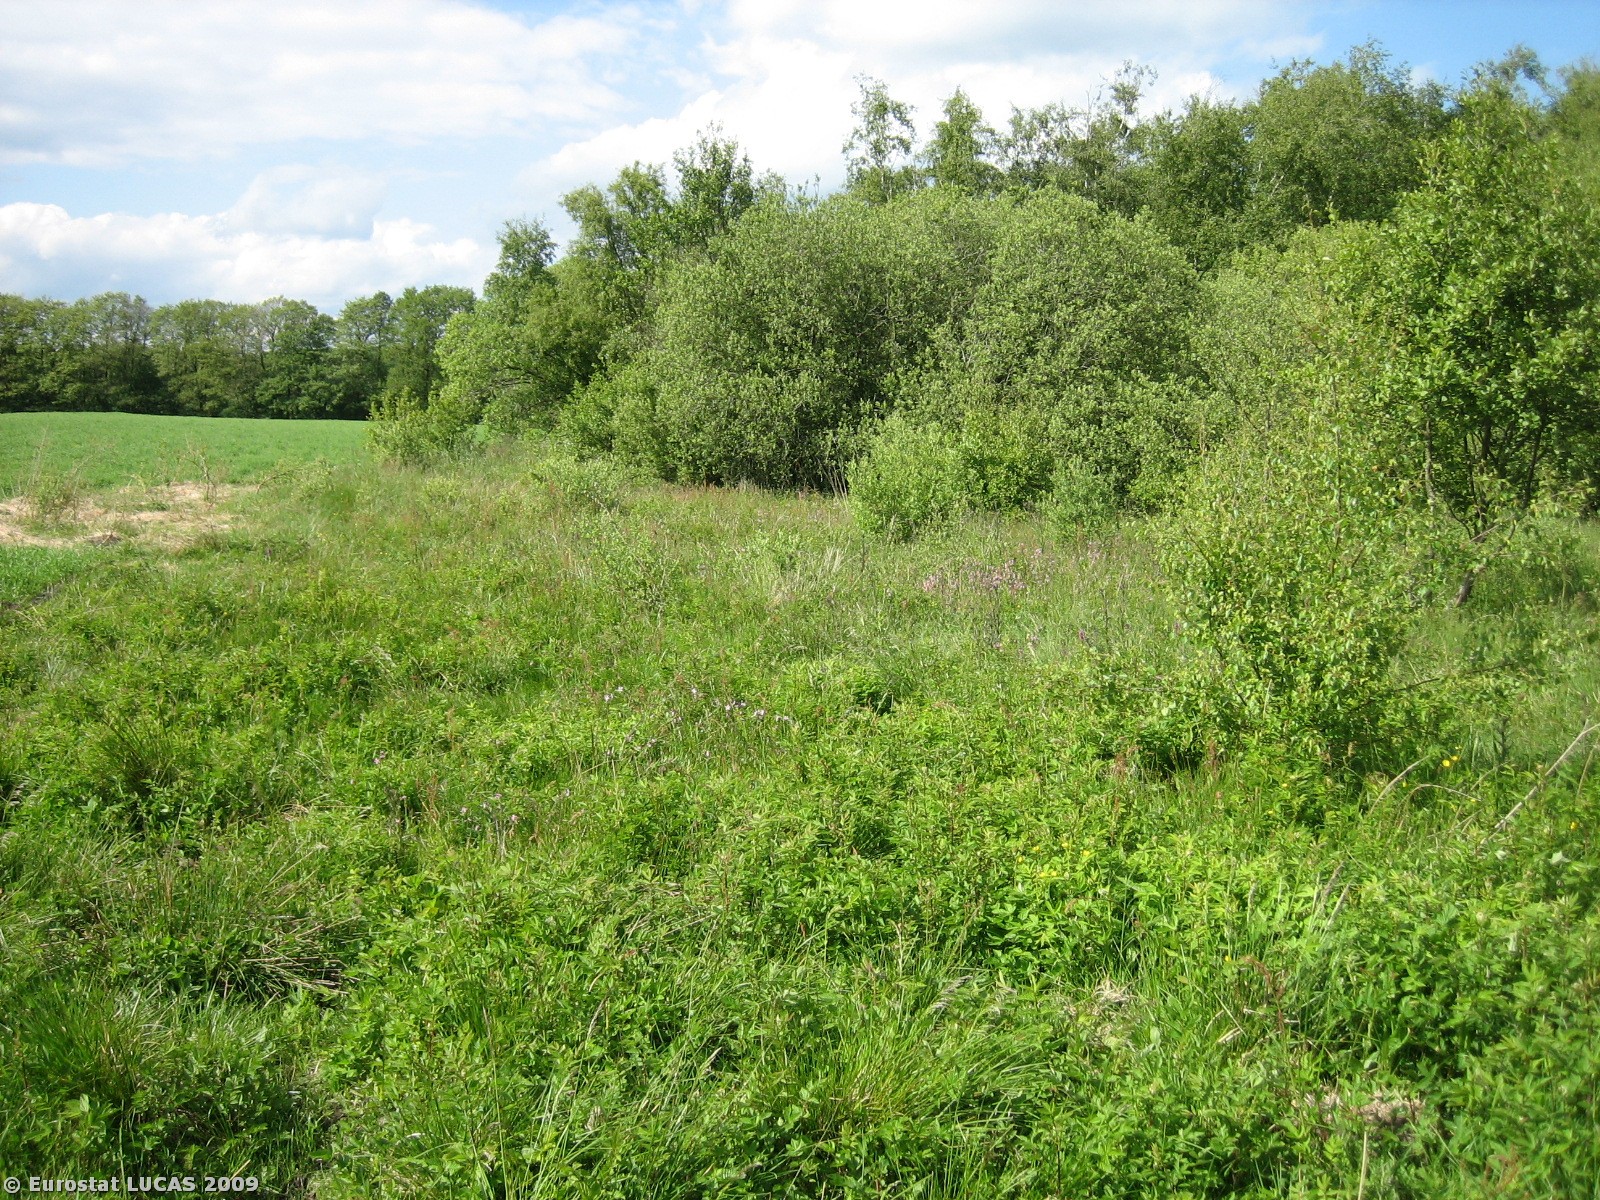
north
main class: Cropland
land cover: Barley
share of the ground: > 75 %
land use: Agriculture (excluding fallow land and kitchen gardens)
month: June
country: DK
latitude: 56.0438
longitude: 9.8557
